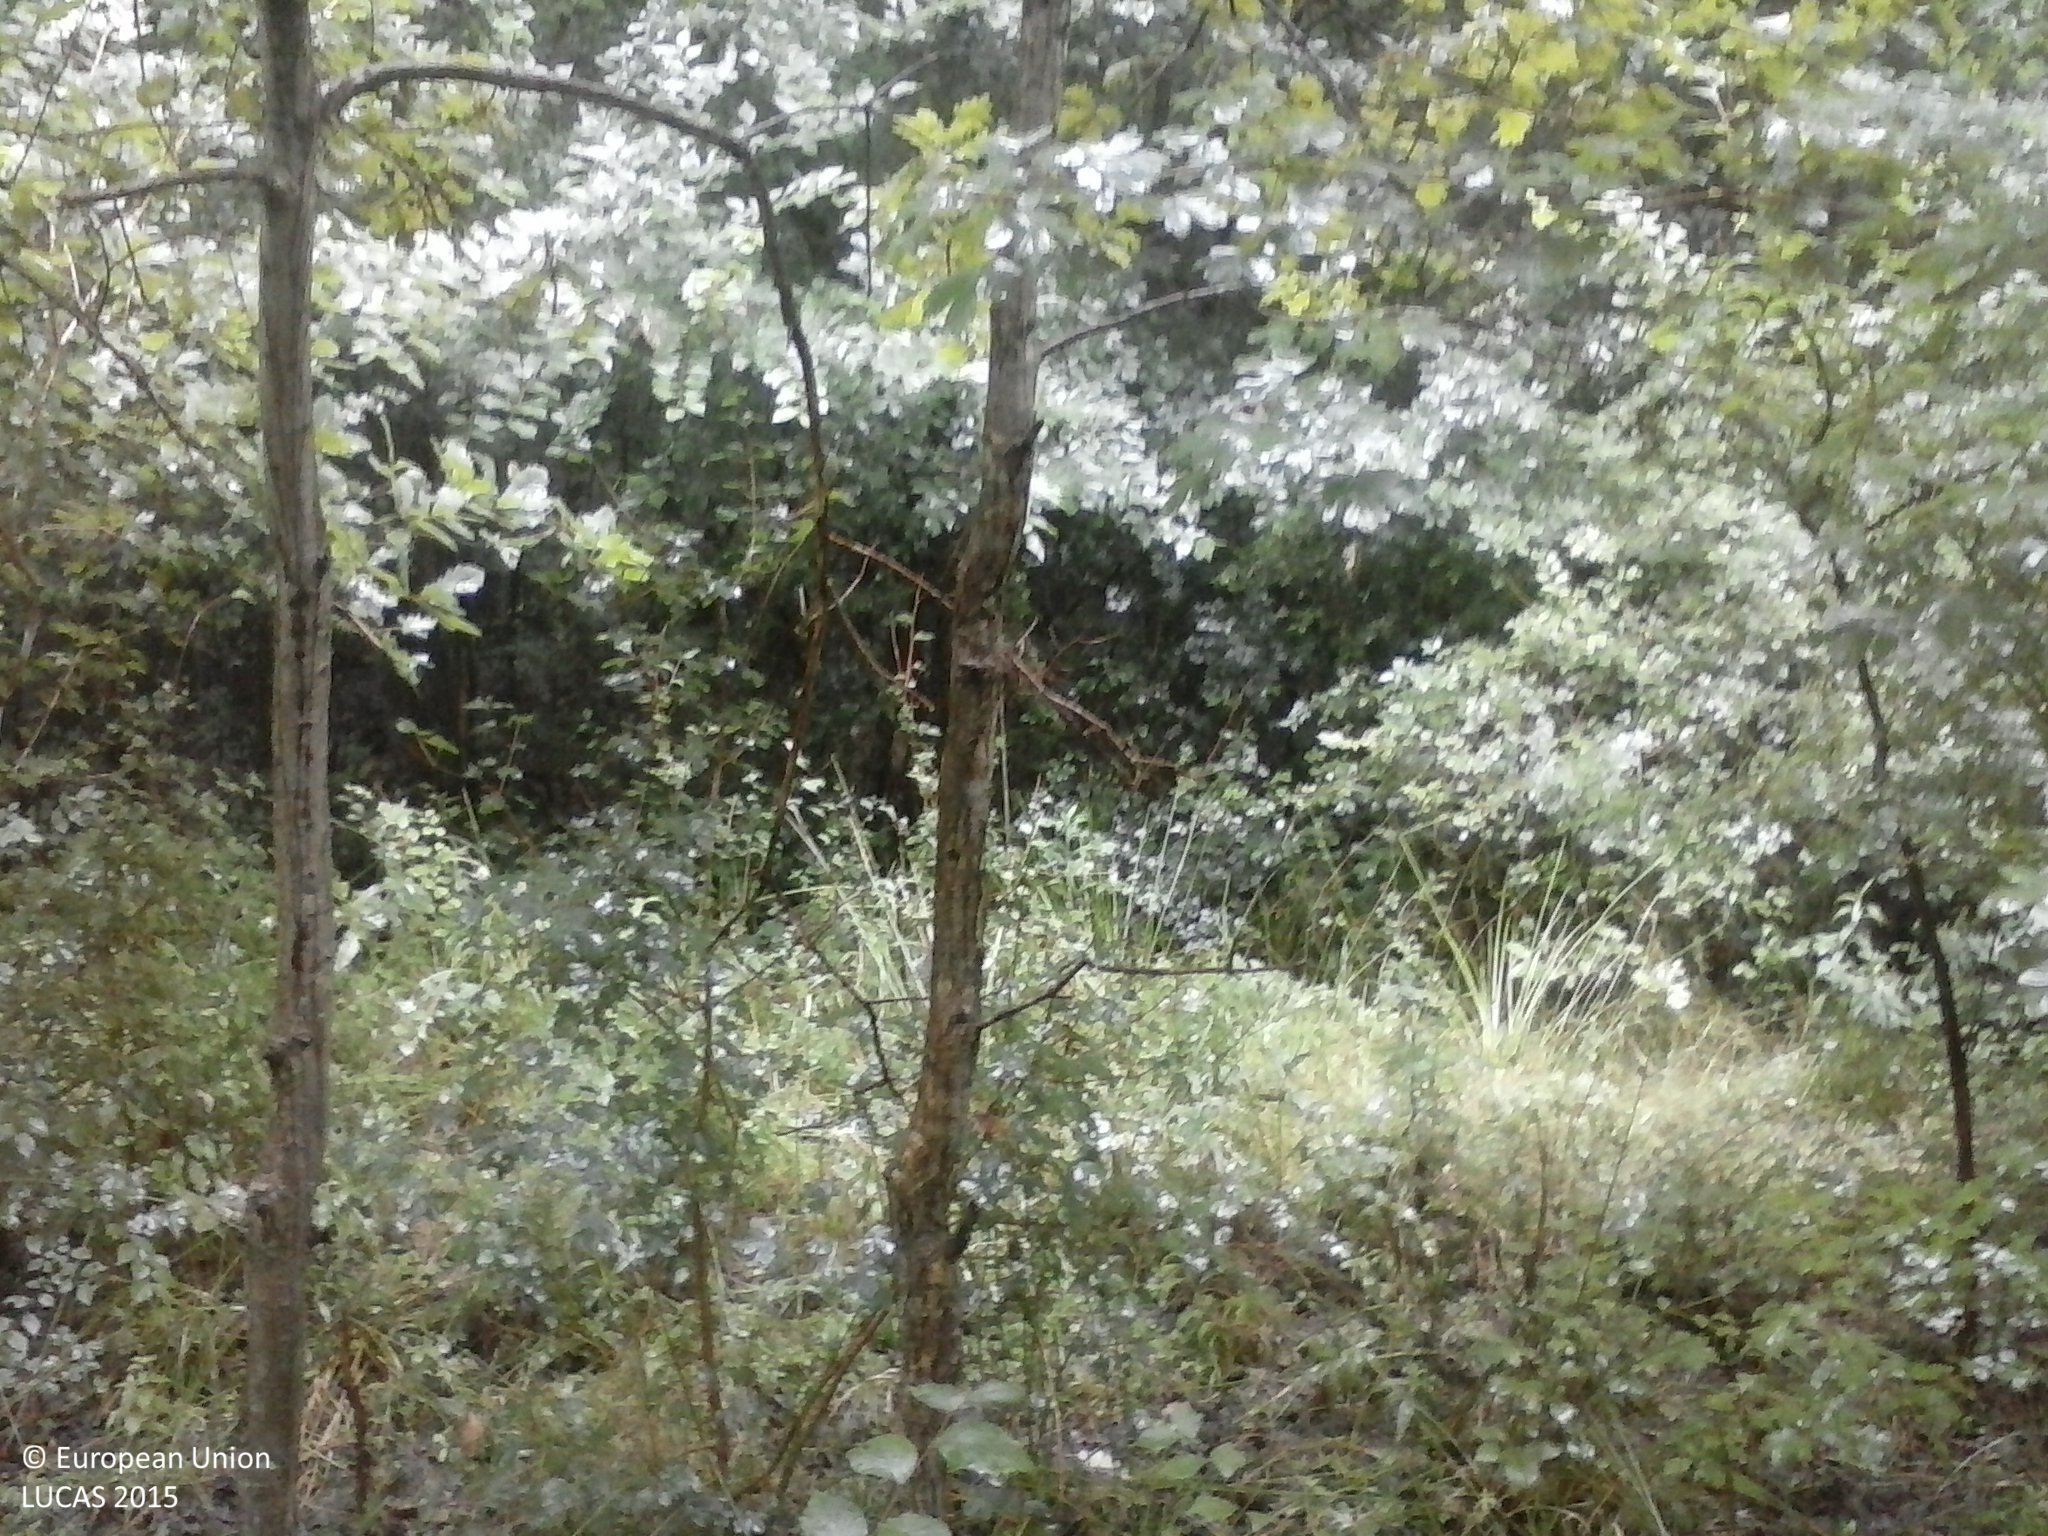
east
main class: Woodland
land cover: Broadleaved woodland
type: exotic forest
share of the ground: > 75 %
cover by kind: broadleaved forest trees 90 %, shrubs 5 %, herbaceous plants 5 %
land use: Forestry
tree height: > 5 m
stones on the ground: < 10 %
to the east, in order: Broadleaved woodland
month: July
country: HU
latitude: 45.9519
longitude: 17.6283
